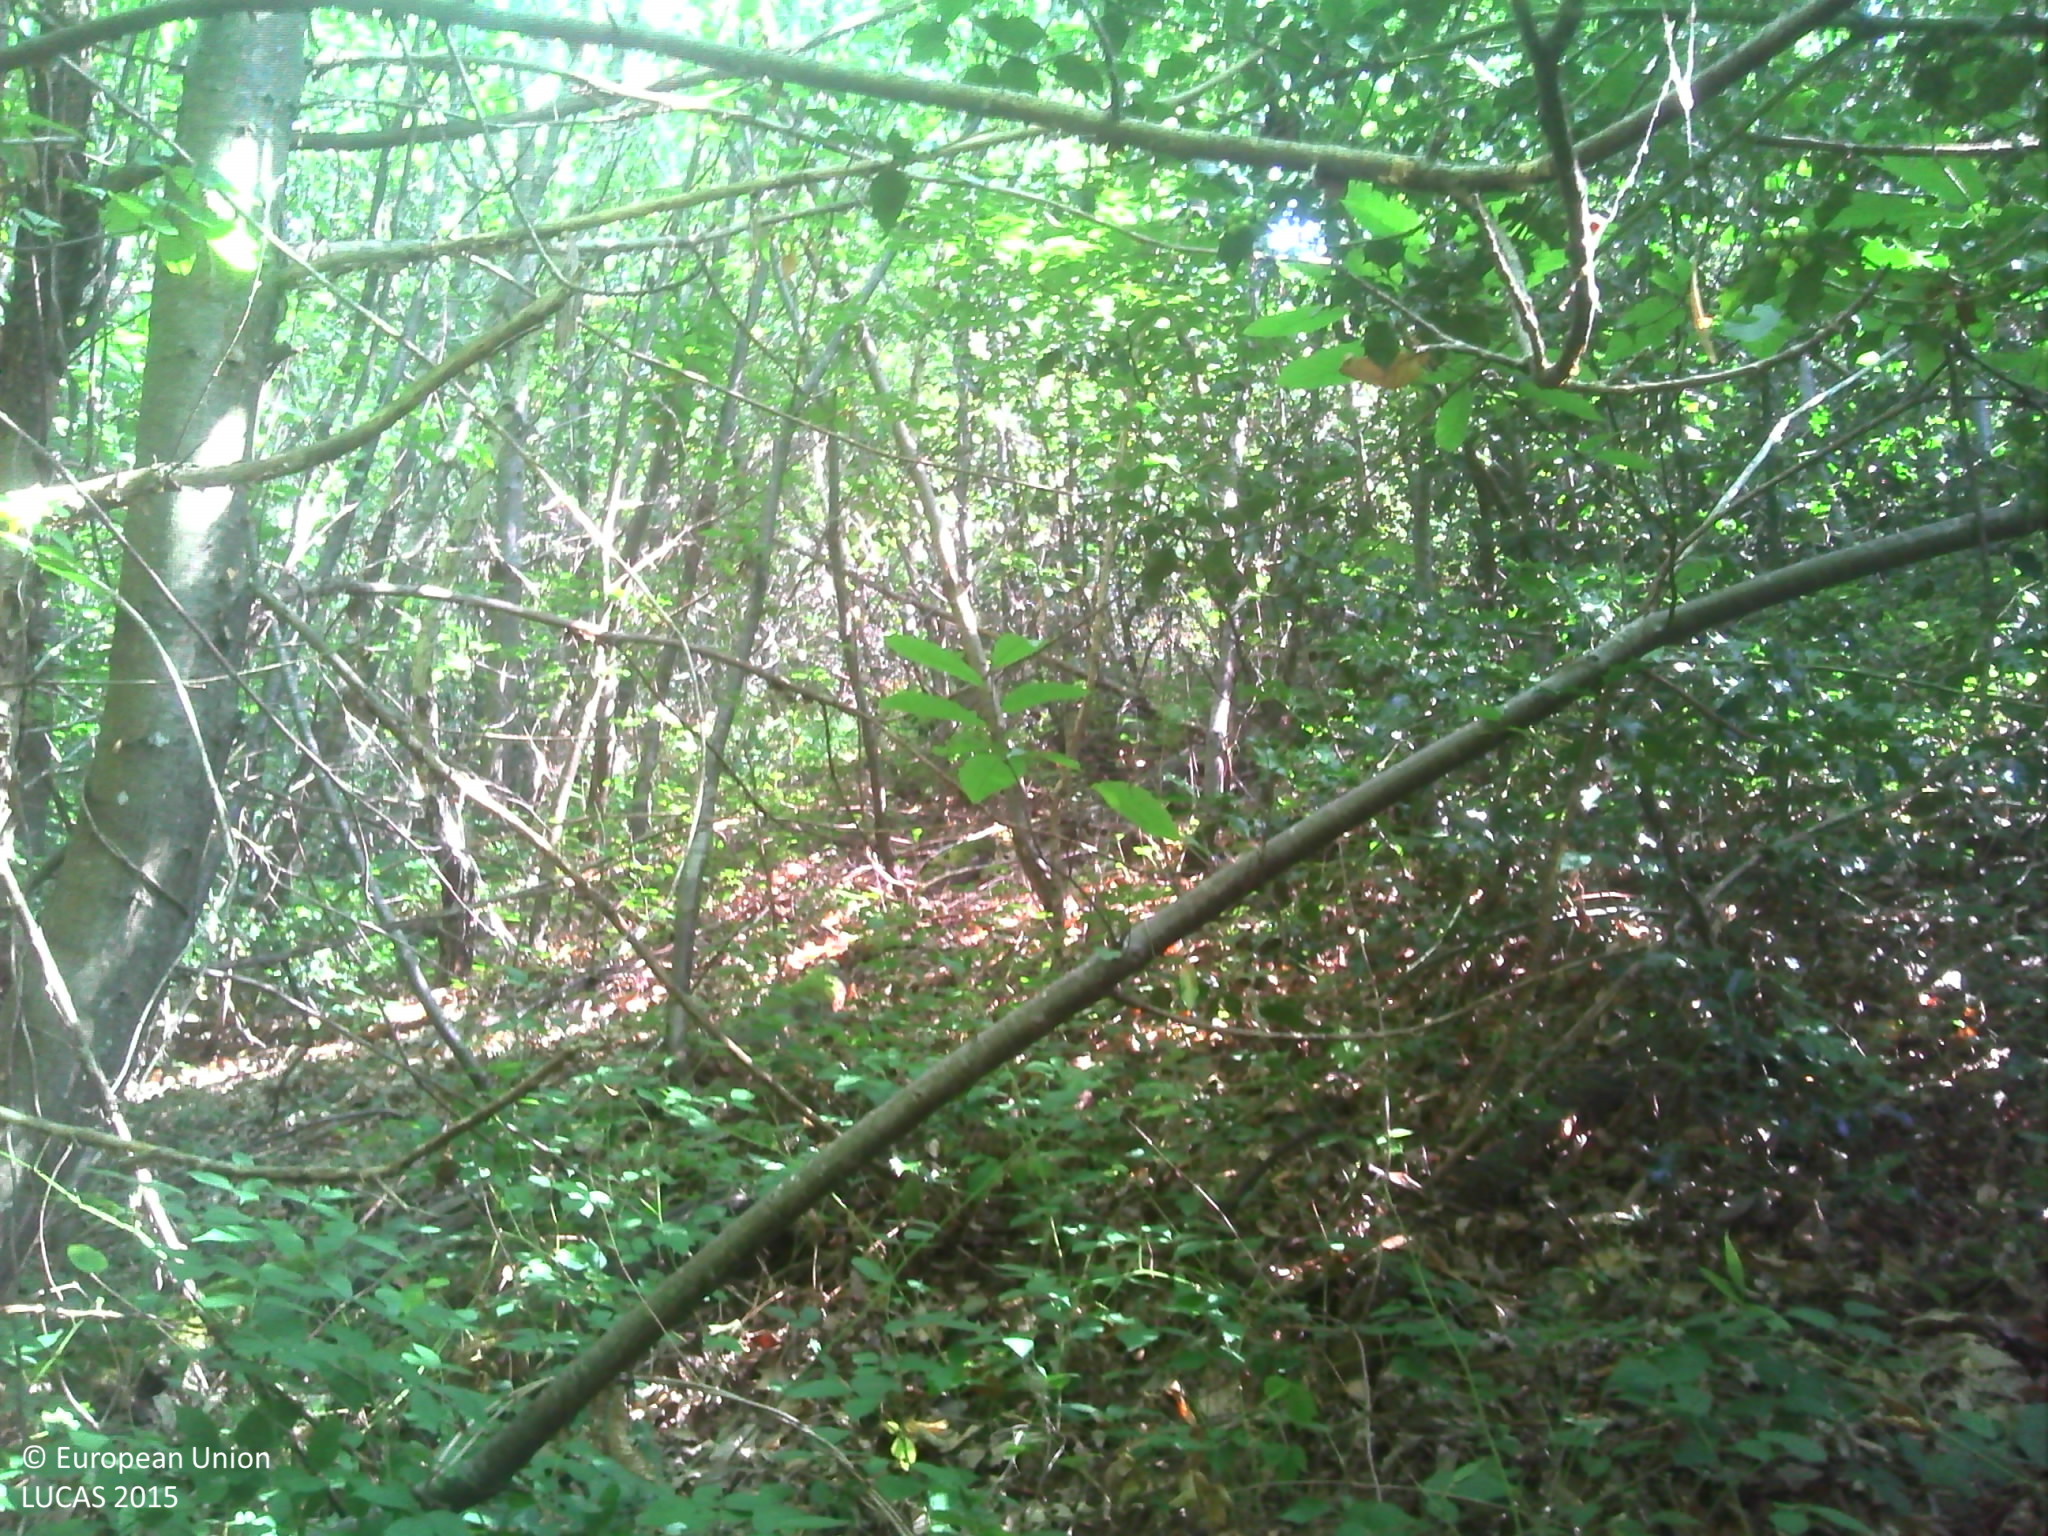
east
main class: Woodland
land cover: Broadleaved woodland
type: floodplain forest
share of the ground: > 75 %
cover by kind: broadleaved forest trees 95 %, coniferous forest trees 5 %
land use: Forestry
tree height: > 5 m
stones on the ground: 10 - 25 %
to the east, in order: Broadleaved woodland; Tracks; Broadleaved woodland; Grass margins; Temporary grasslands
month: September
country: FR
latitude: 45.2318
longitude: 5.1777
